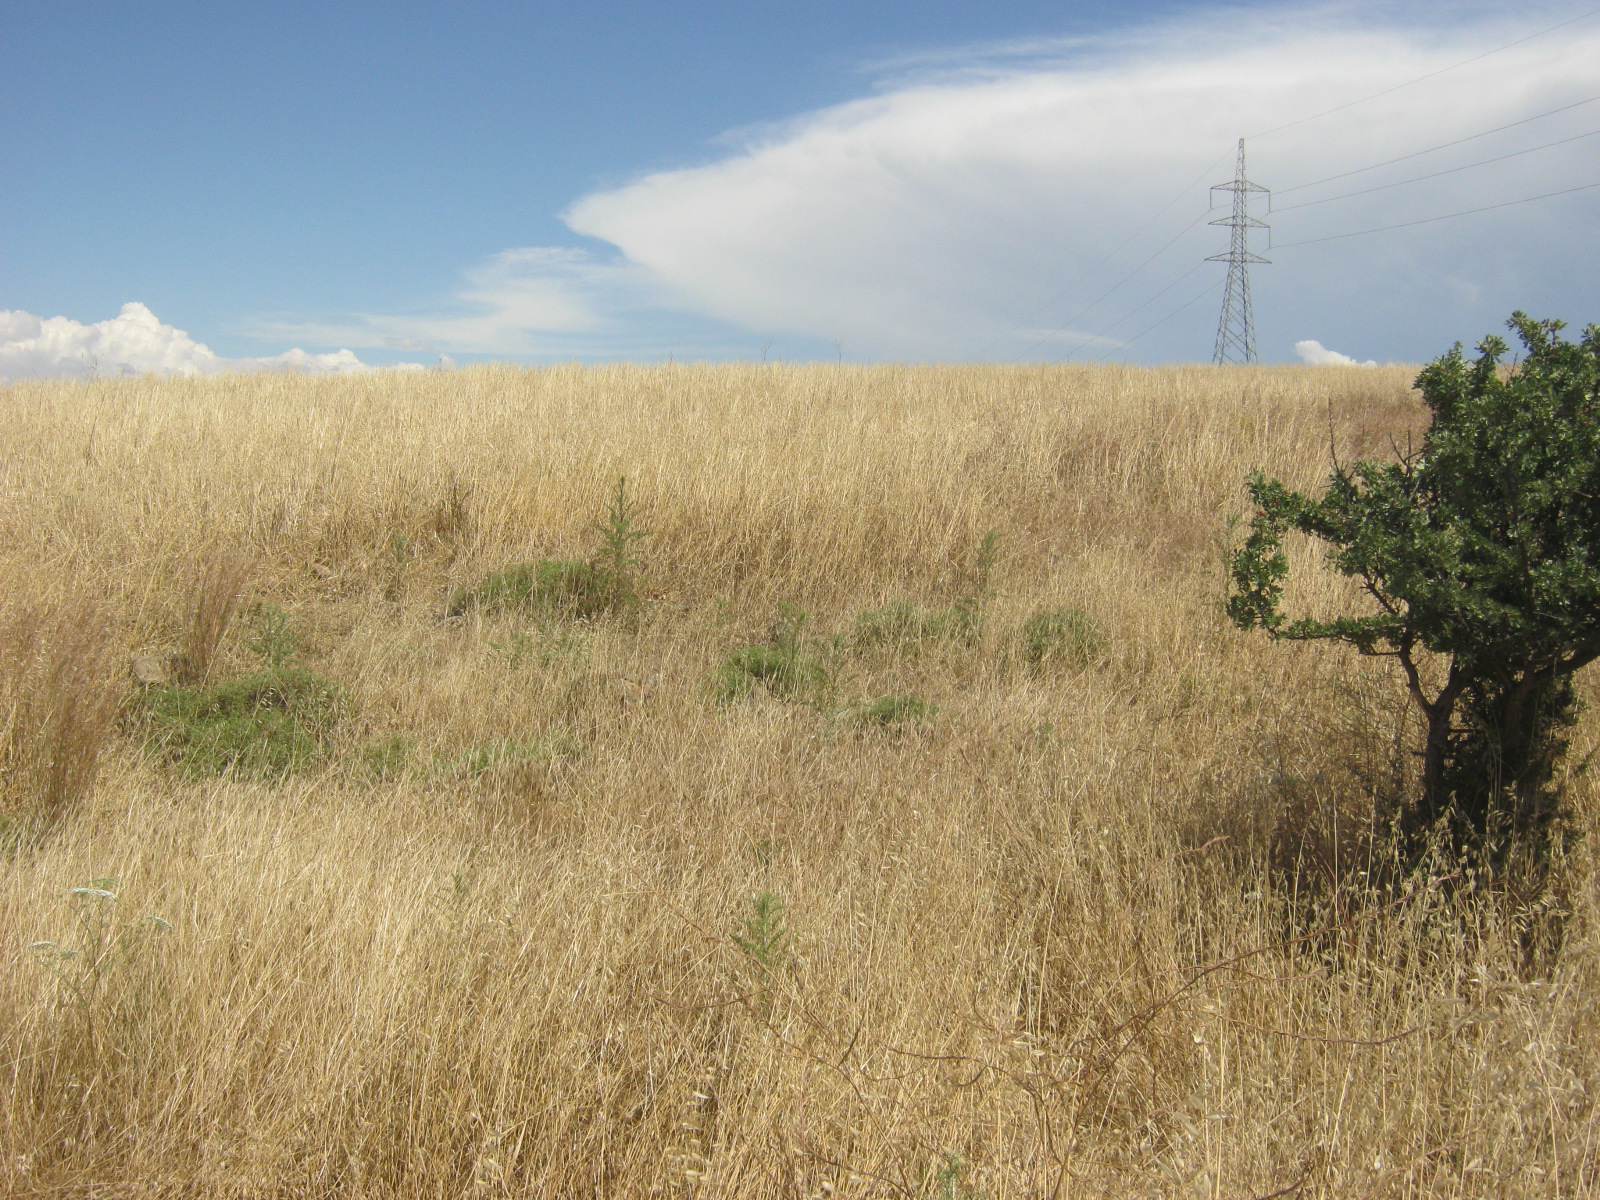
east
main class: Grassland
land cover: Grassland with sparse tree/shrub cover
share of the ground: > 75 %
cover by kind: herbaceous plants 95 %, broadleaved forest trees 5 %
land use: Semi-natural and natural areas not in use
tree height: < 5 m
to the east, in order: Grassland with sparse tree/shrub cover; Barley
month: May
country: CY
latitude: 35.1222
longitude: 33.0363
